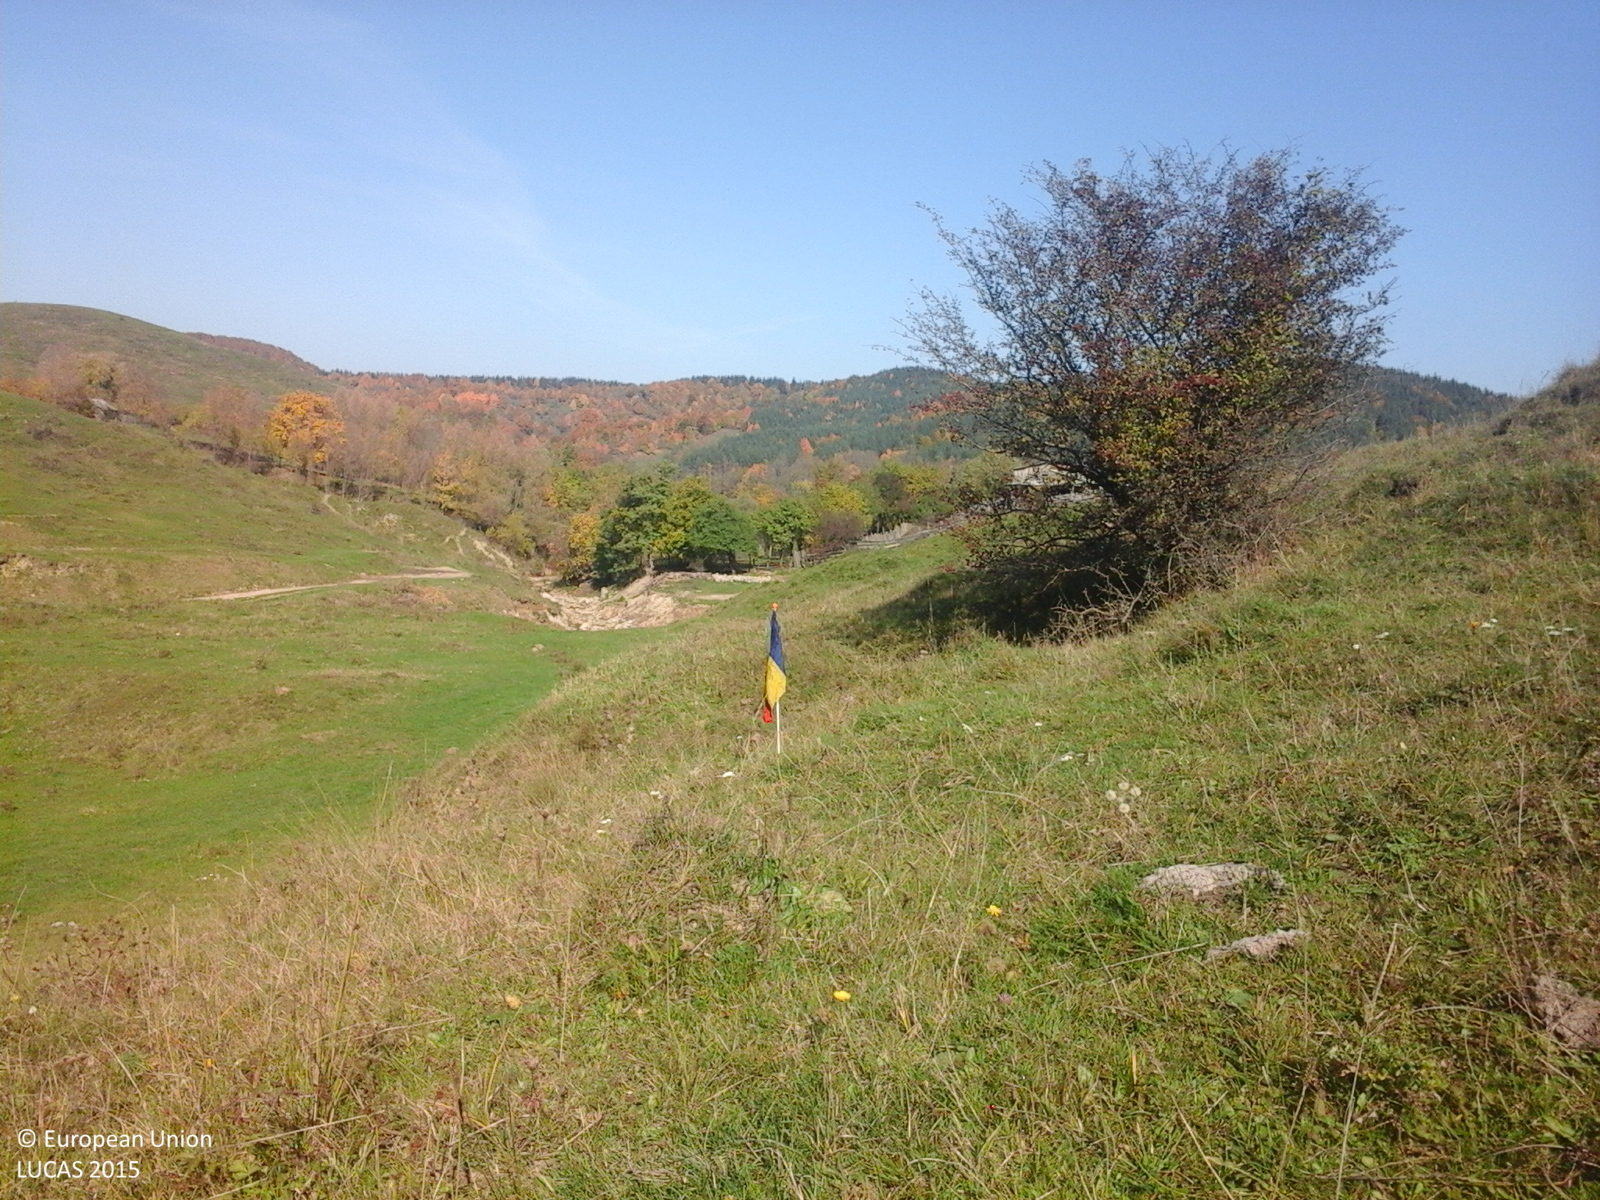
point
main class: Grassland
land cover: Grassland without tree/shrub cover
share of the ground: > 75 %
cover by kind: herbaceous plants 100 %
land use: Agriculture (excluding fallow land and kitchen gardens)
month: October
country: RO
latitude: 46.0311
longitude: 26.7384
